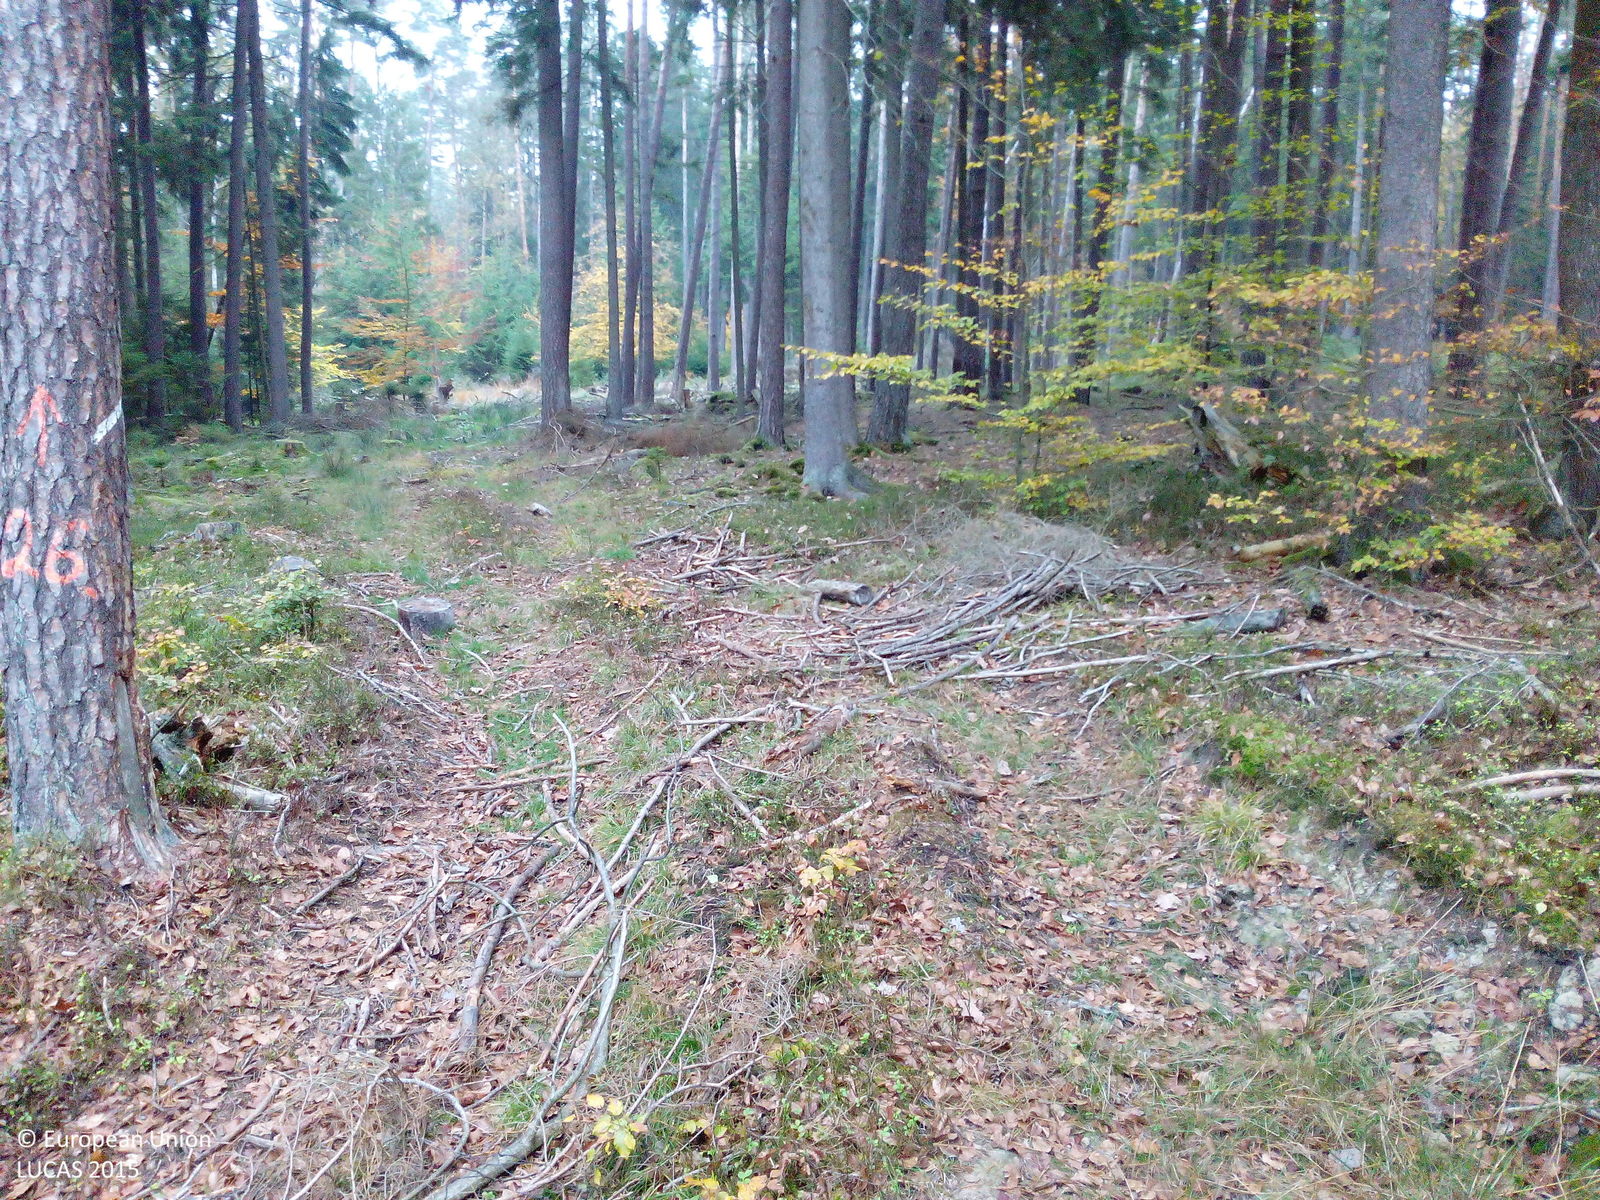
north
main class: Woodland
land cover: Other mixed woodland
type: hemiboreal forest and nemoral coniferous forest and mixed broadleaved-coniferous forest
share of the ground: > 75 %
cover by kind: coniferous forest trees 50 %, broadleaved forest trees 30 %, shrubs 10 %, unconsolidated bare surface 10 %
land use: Forestry
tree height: > 5 m
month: October
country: DE
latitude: 50.2022
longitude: 9.9020
